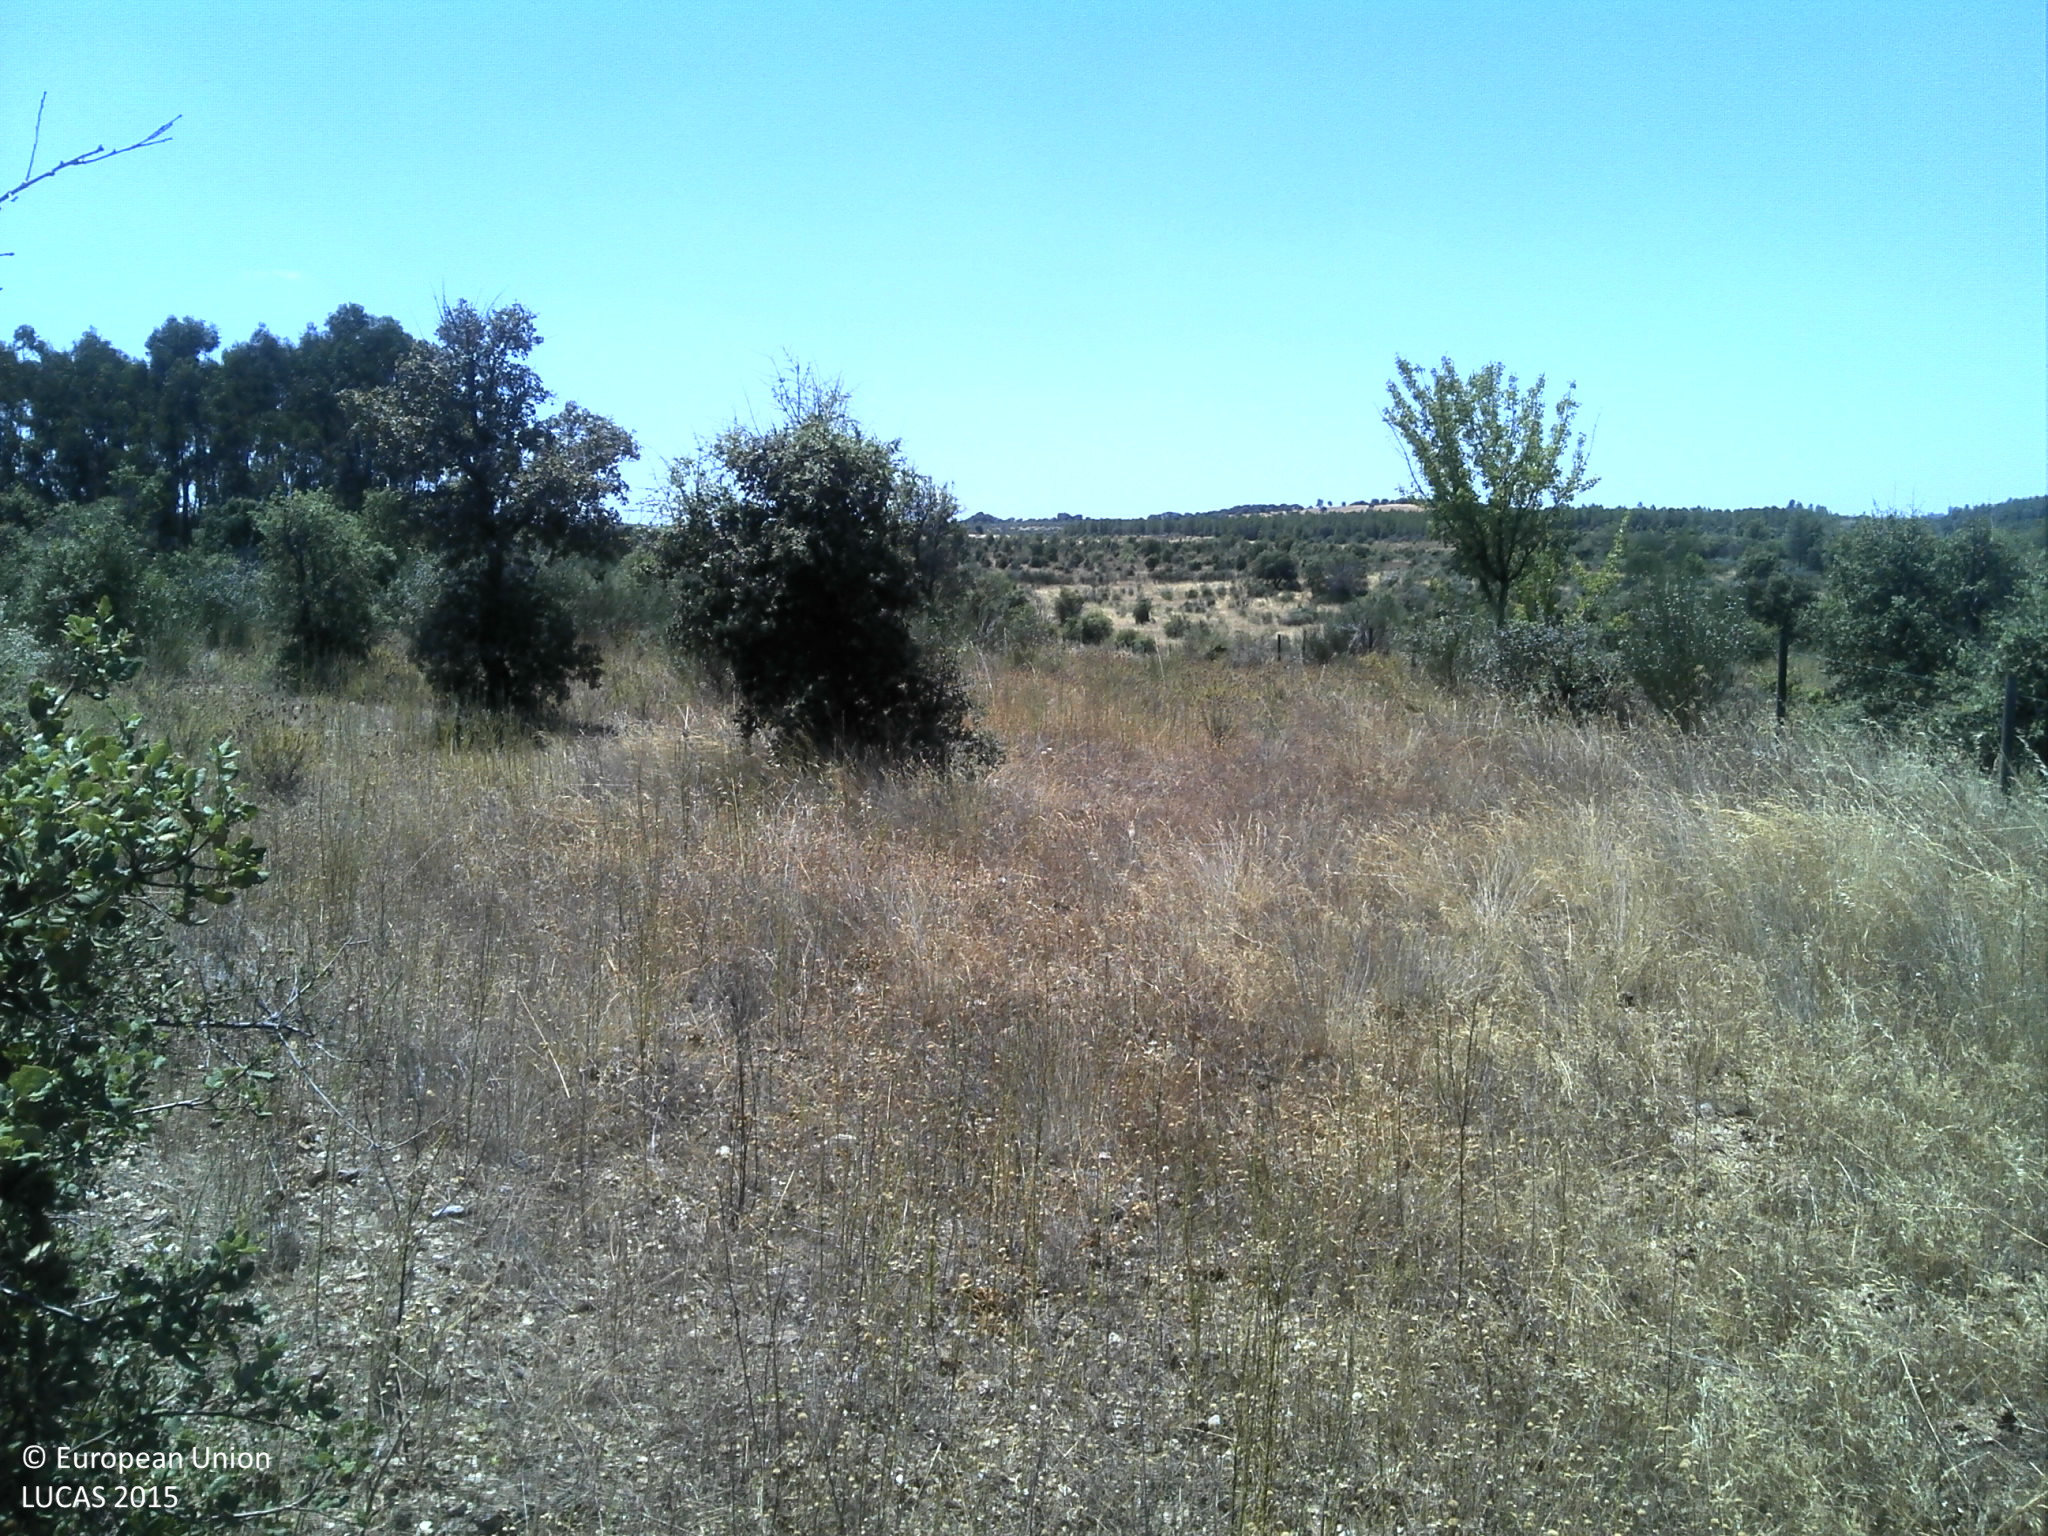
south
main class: Woodland
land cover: Broadleaved woodland
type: broadleaved evergreen forest
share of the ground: 10 - 25 %
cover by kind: unconsolidated bare surface 35 %, broadleaved forest trees 25 %, shrubs 20 %, herbaceous plants 20 %
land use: Forestry
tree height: < 5 m
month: June
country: PT
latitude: 40.1037
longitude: -7.2849
